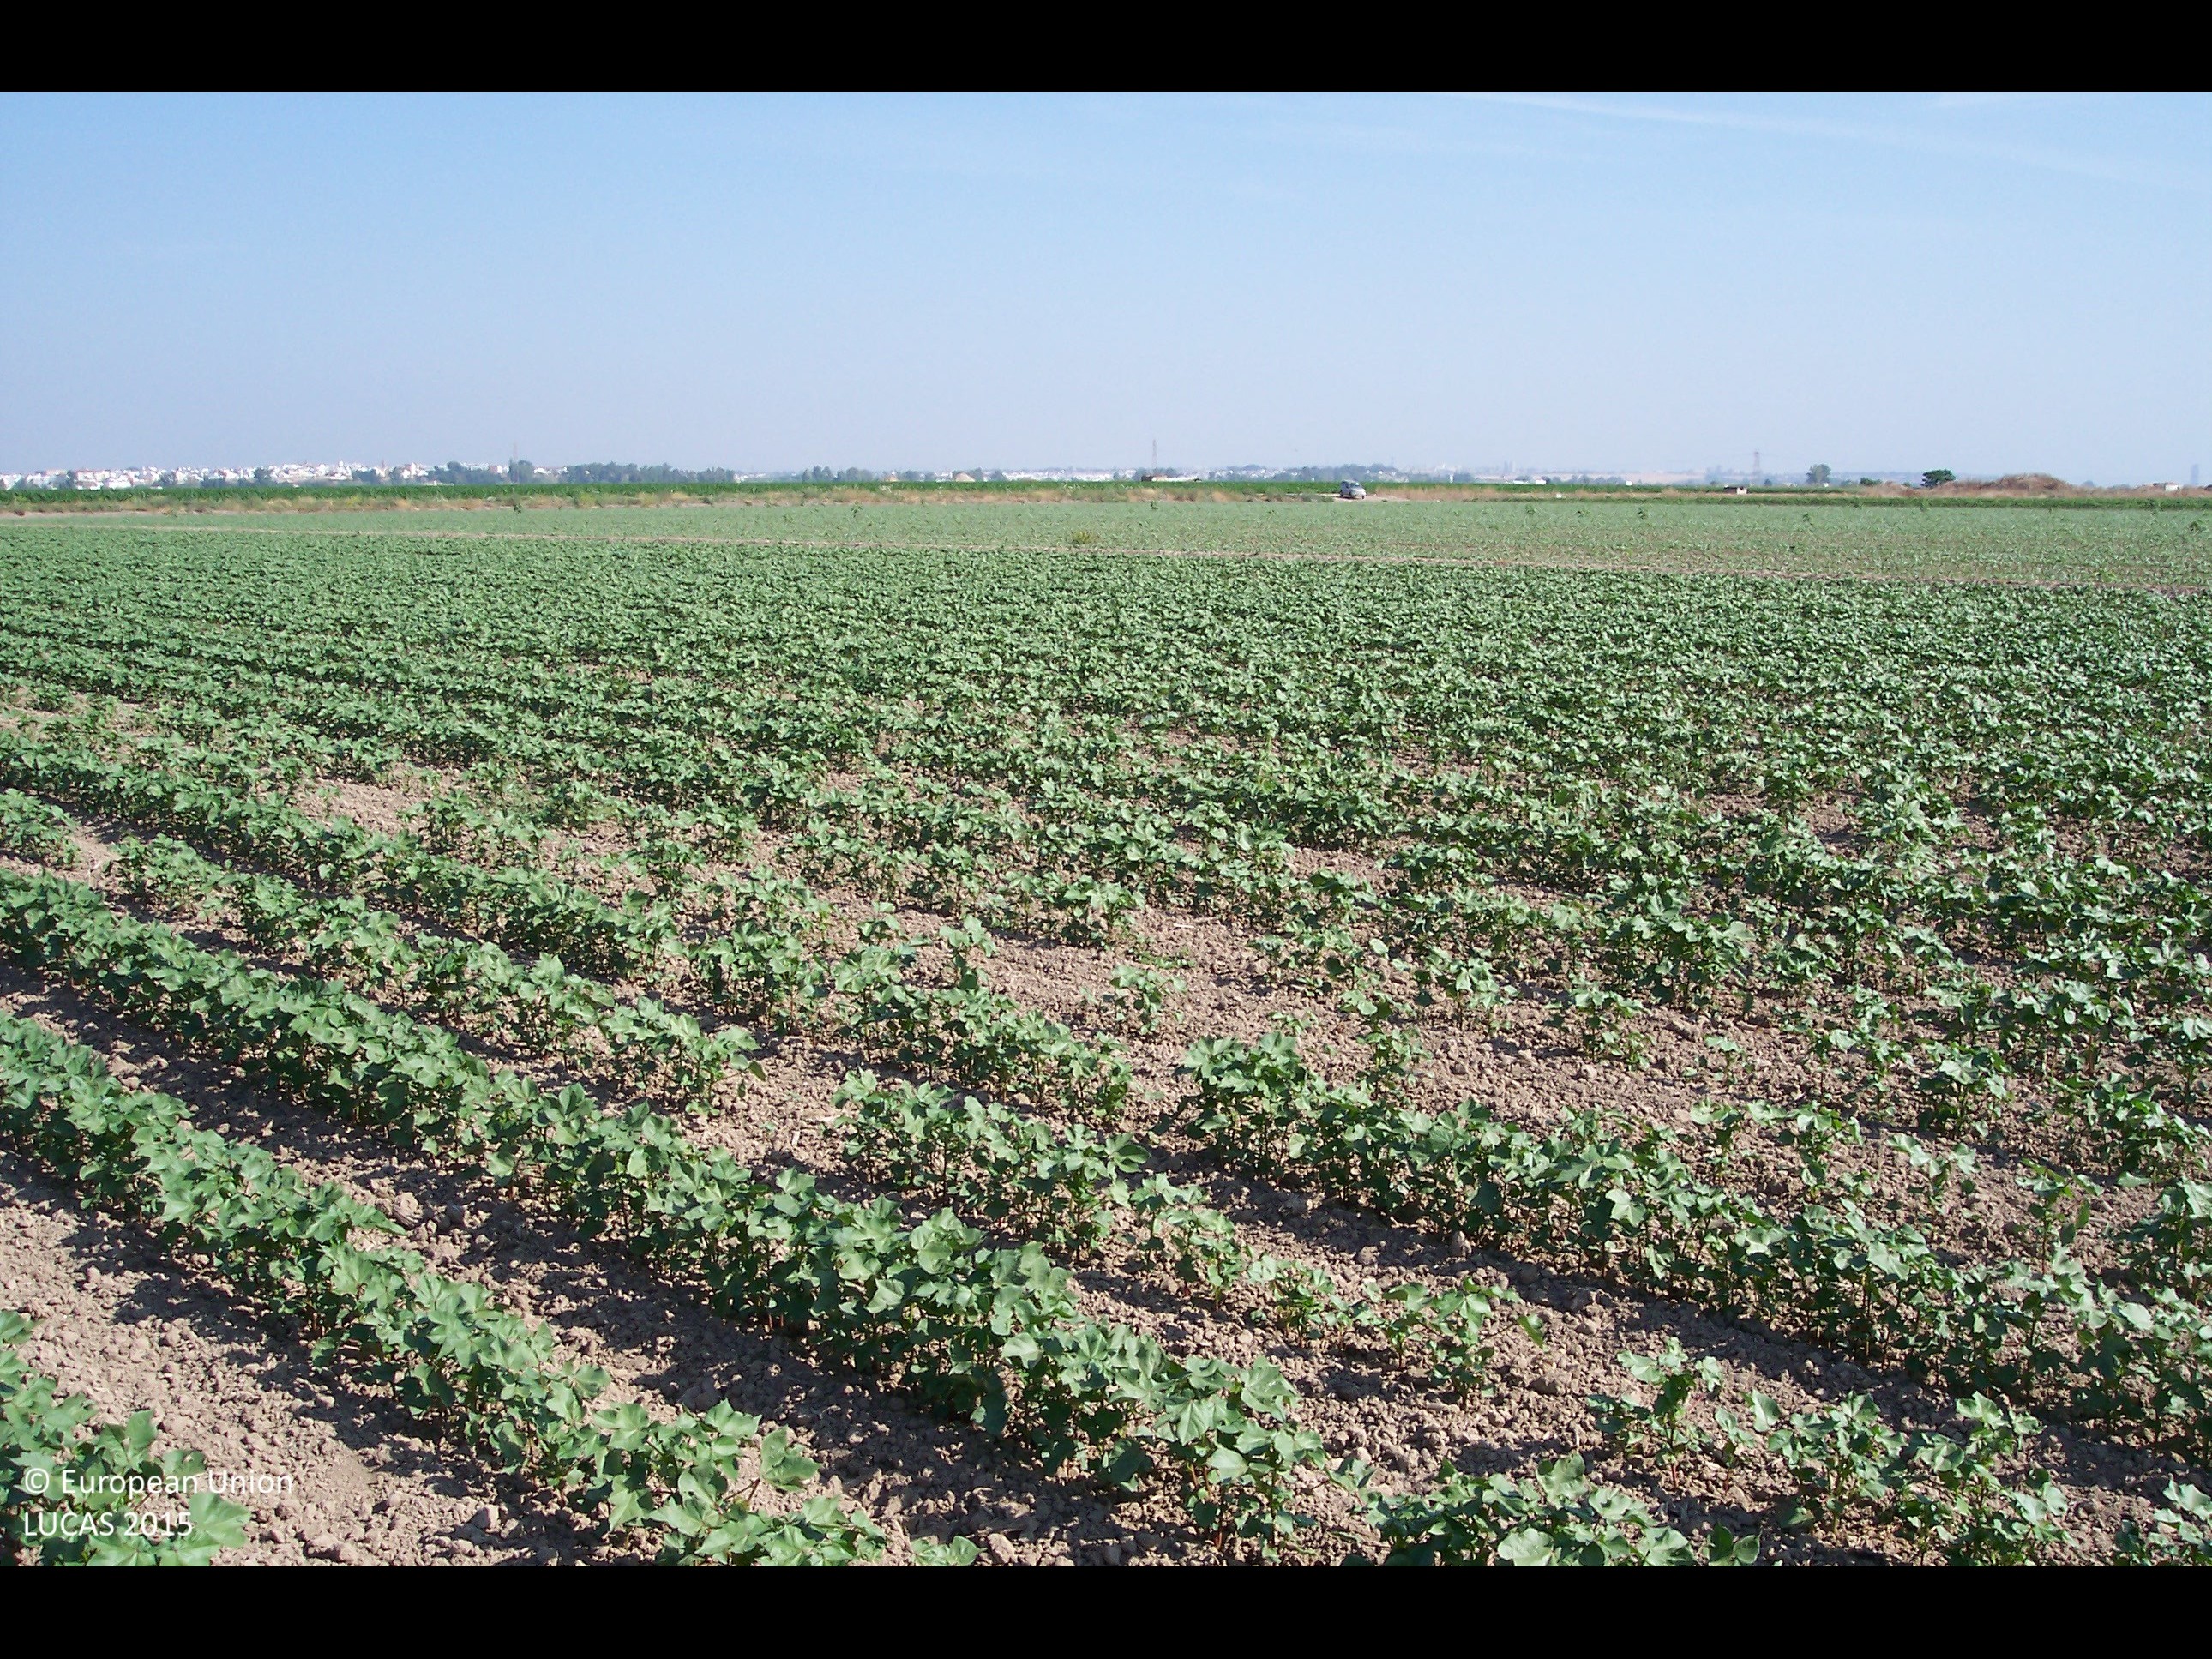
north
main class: Cropland
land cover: Cotton
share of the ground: 25 - 50 %
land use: Agriculture (excluding fallow land and kitchen gardens)
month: May
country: ES
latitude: 37.2430
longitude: -6.0406
